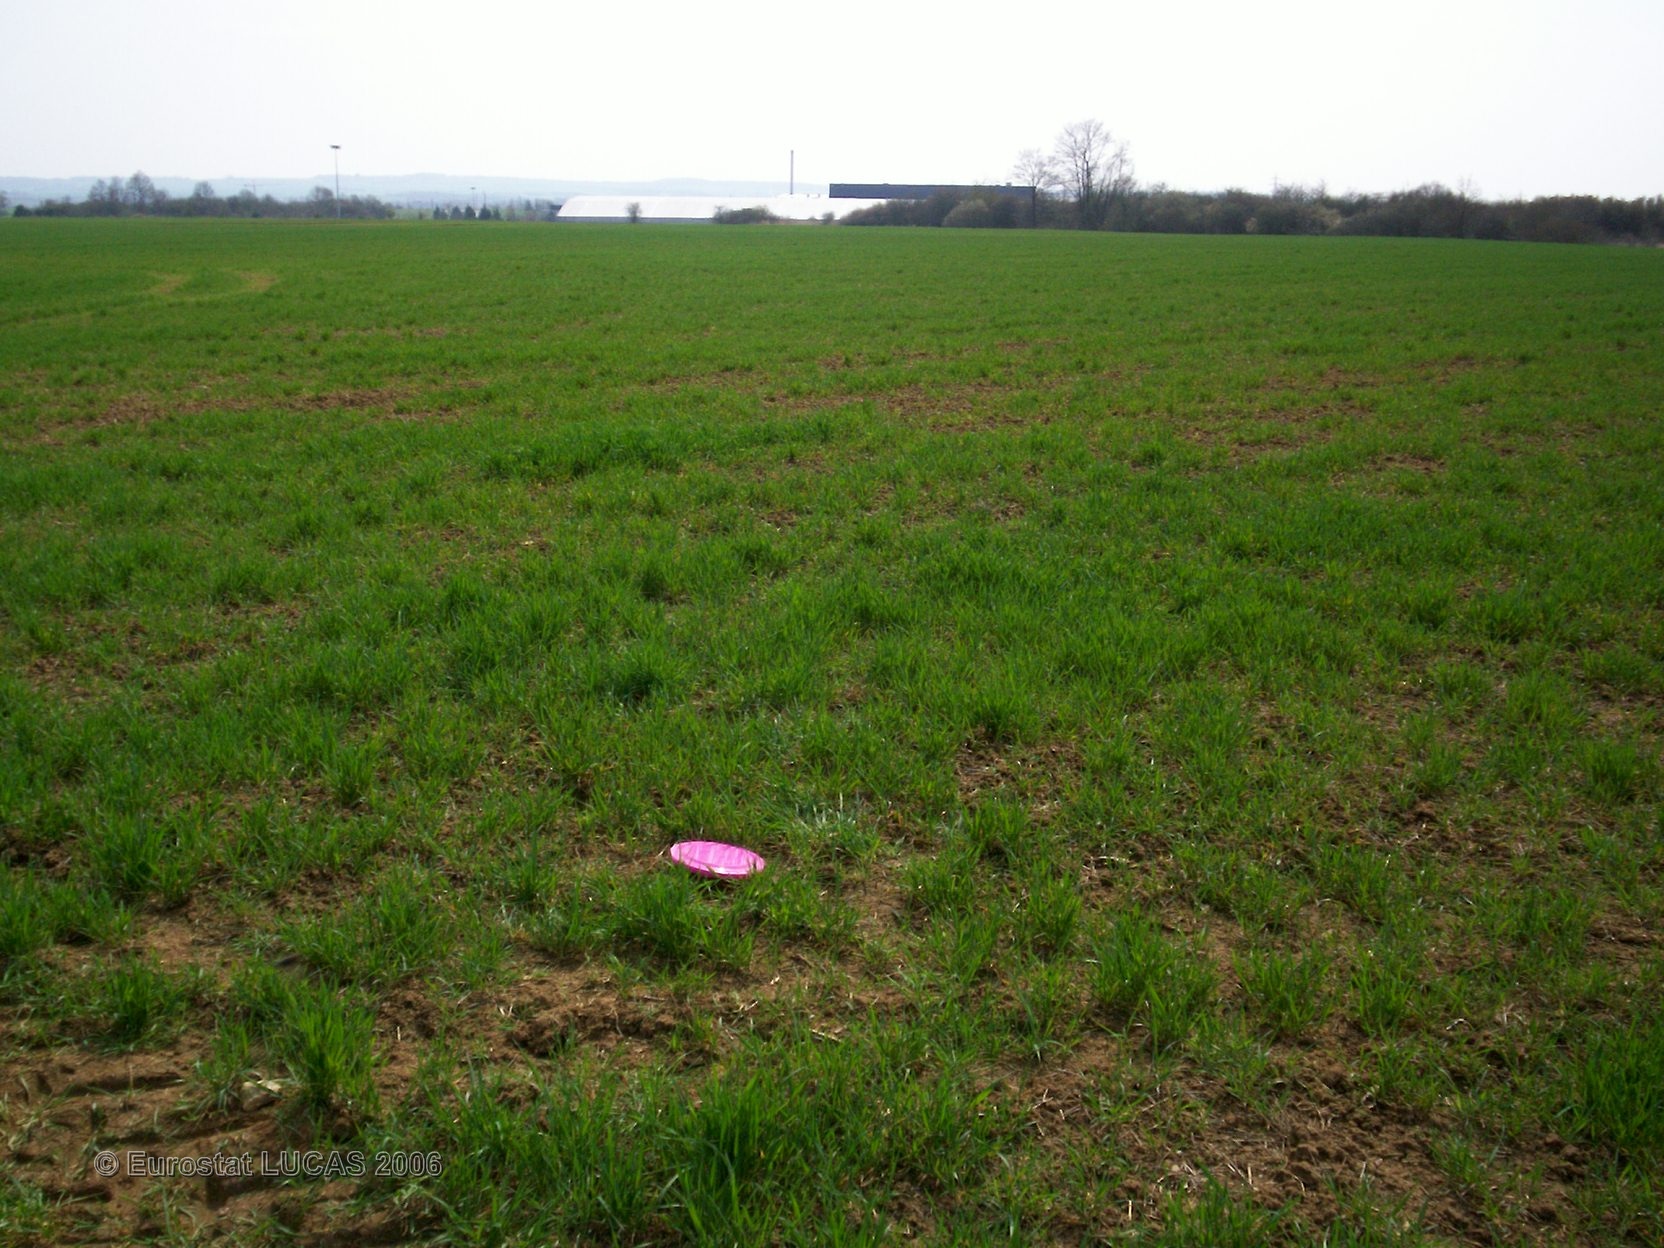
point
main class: Cropland
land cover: Common wheat
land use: Agriculture (excluding fallow land and kitchen gardens)
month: April
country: FR
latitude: 48.7261
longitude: 5.9622
